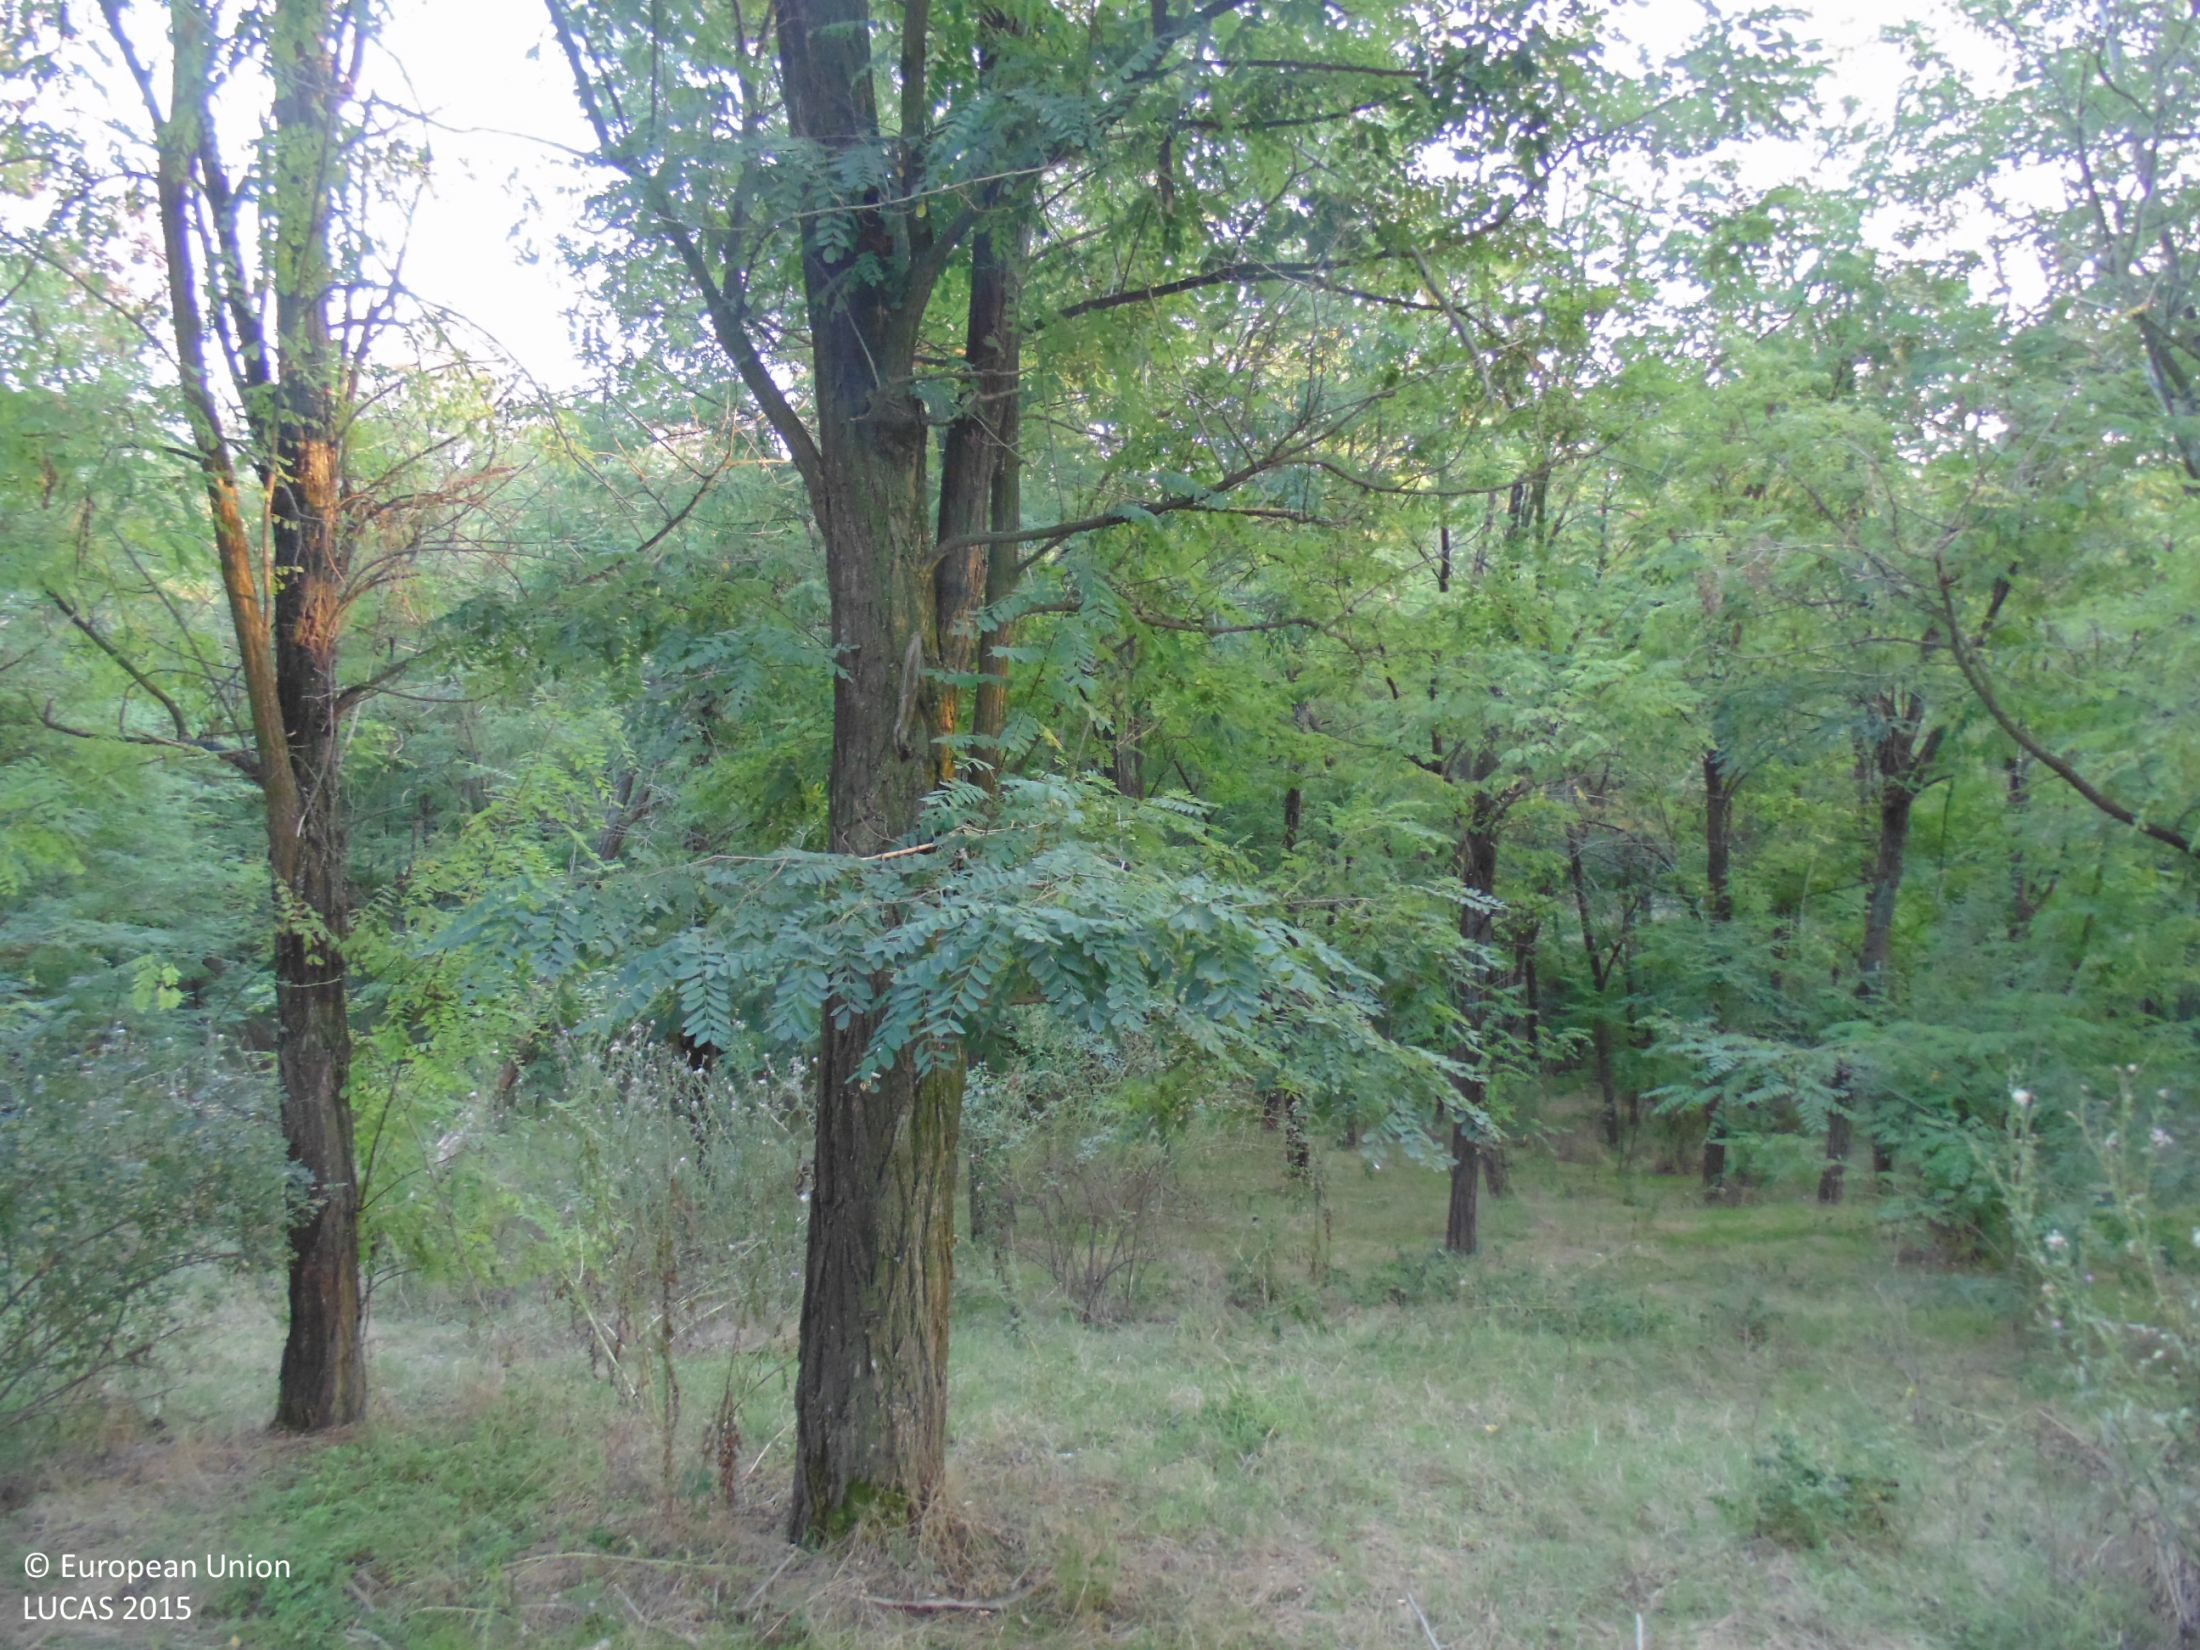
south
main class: Woodland
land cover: Broadleaved woodland
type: mesophytic deciduous forest
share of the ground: > 75 %
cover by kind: broadleaved forest trees 80 %, shrubs 15 %, unconsolidated bare surface 5 %
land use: Forestry
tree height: > 5 m
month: August
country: BG
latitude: 43.6805
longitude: 27.4868
